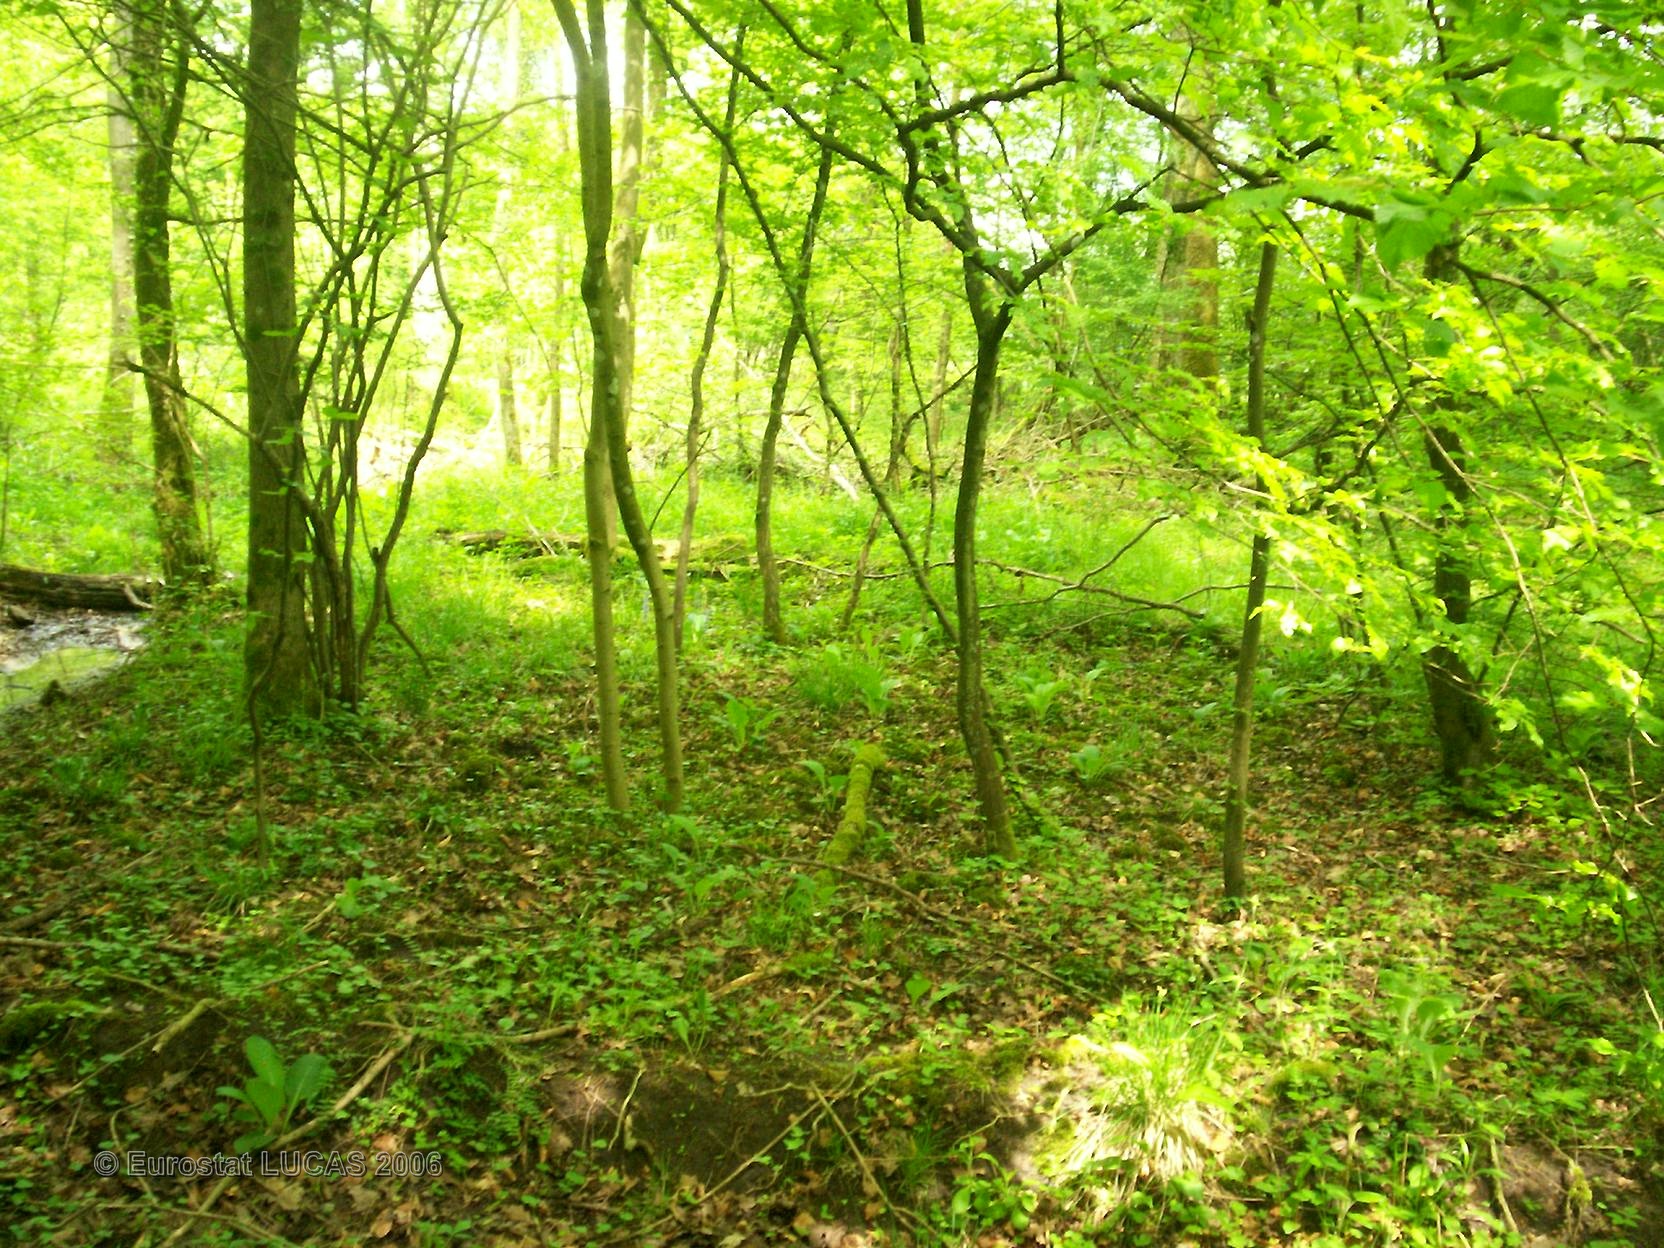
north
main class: Woodland
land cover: Mixed forest
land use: Forestry
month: May
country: FR
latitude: 49.3904
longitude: 6.4316
